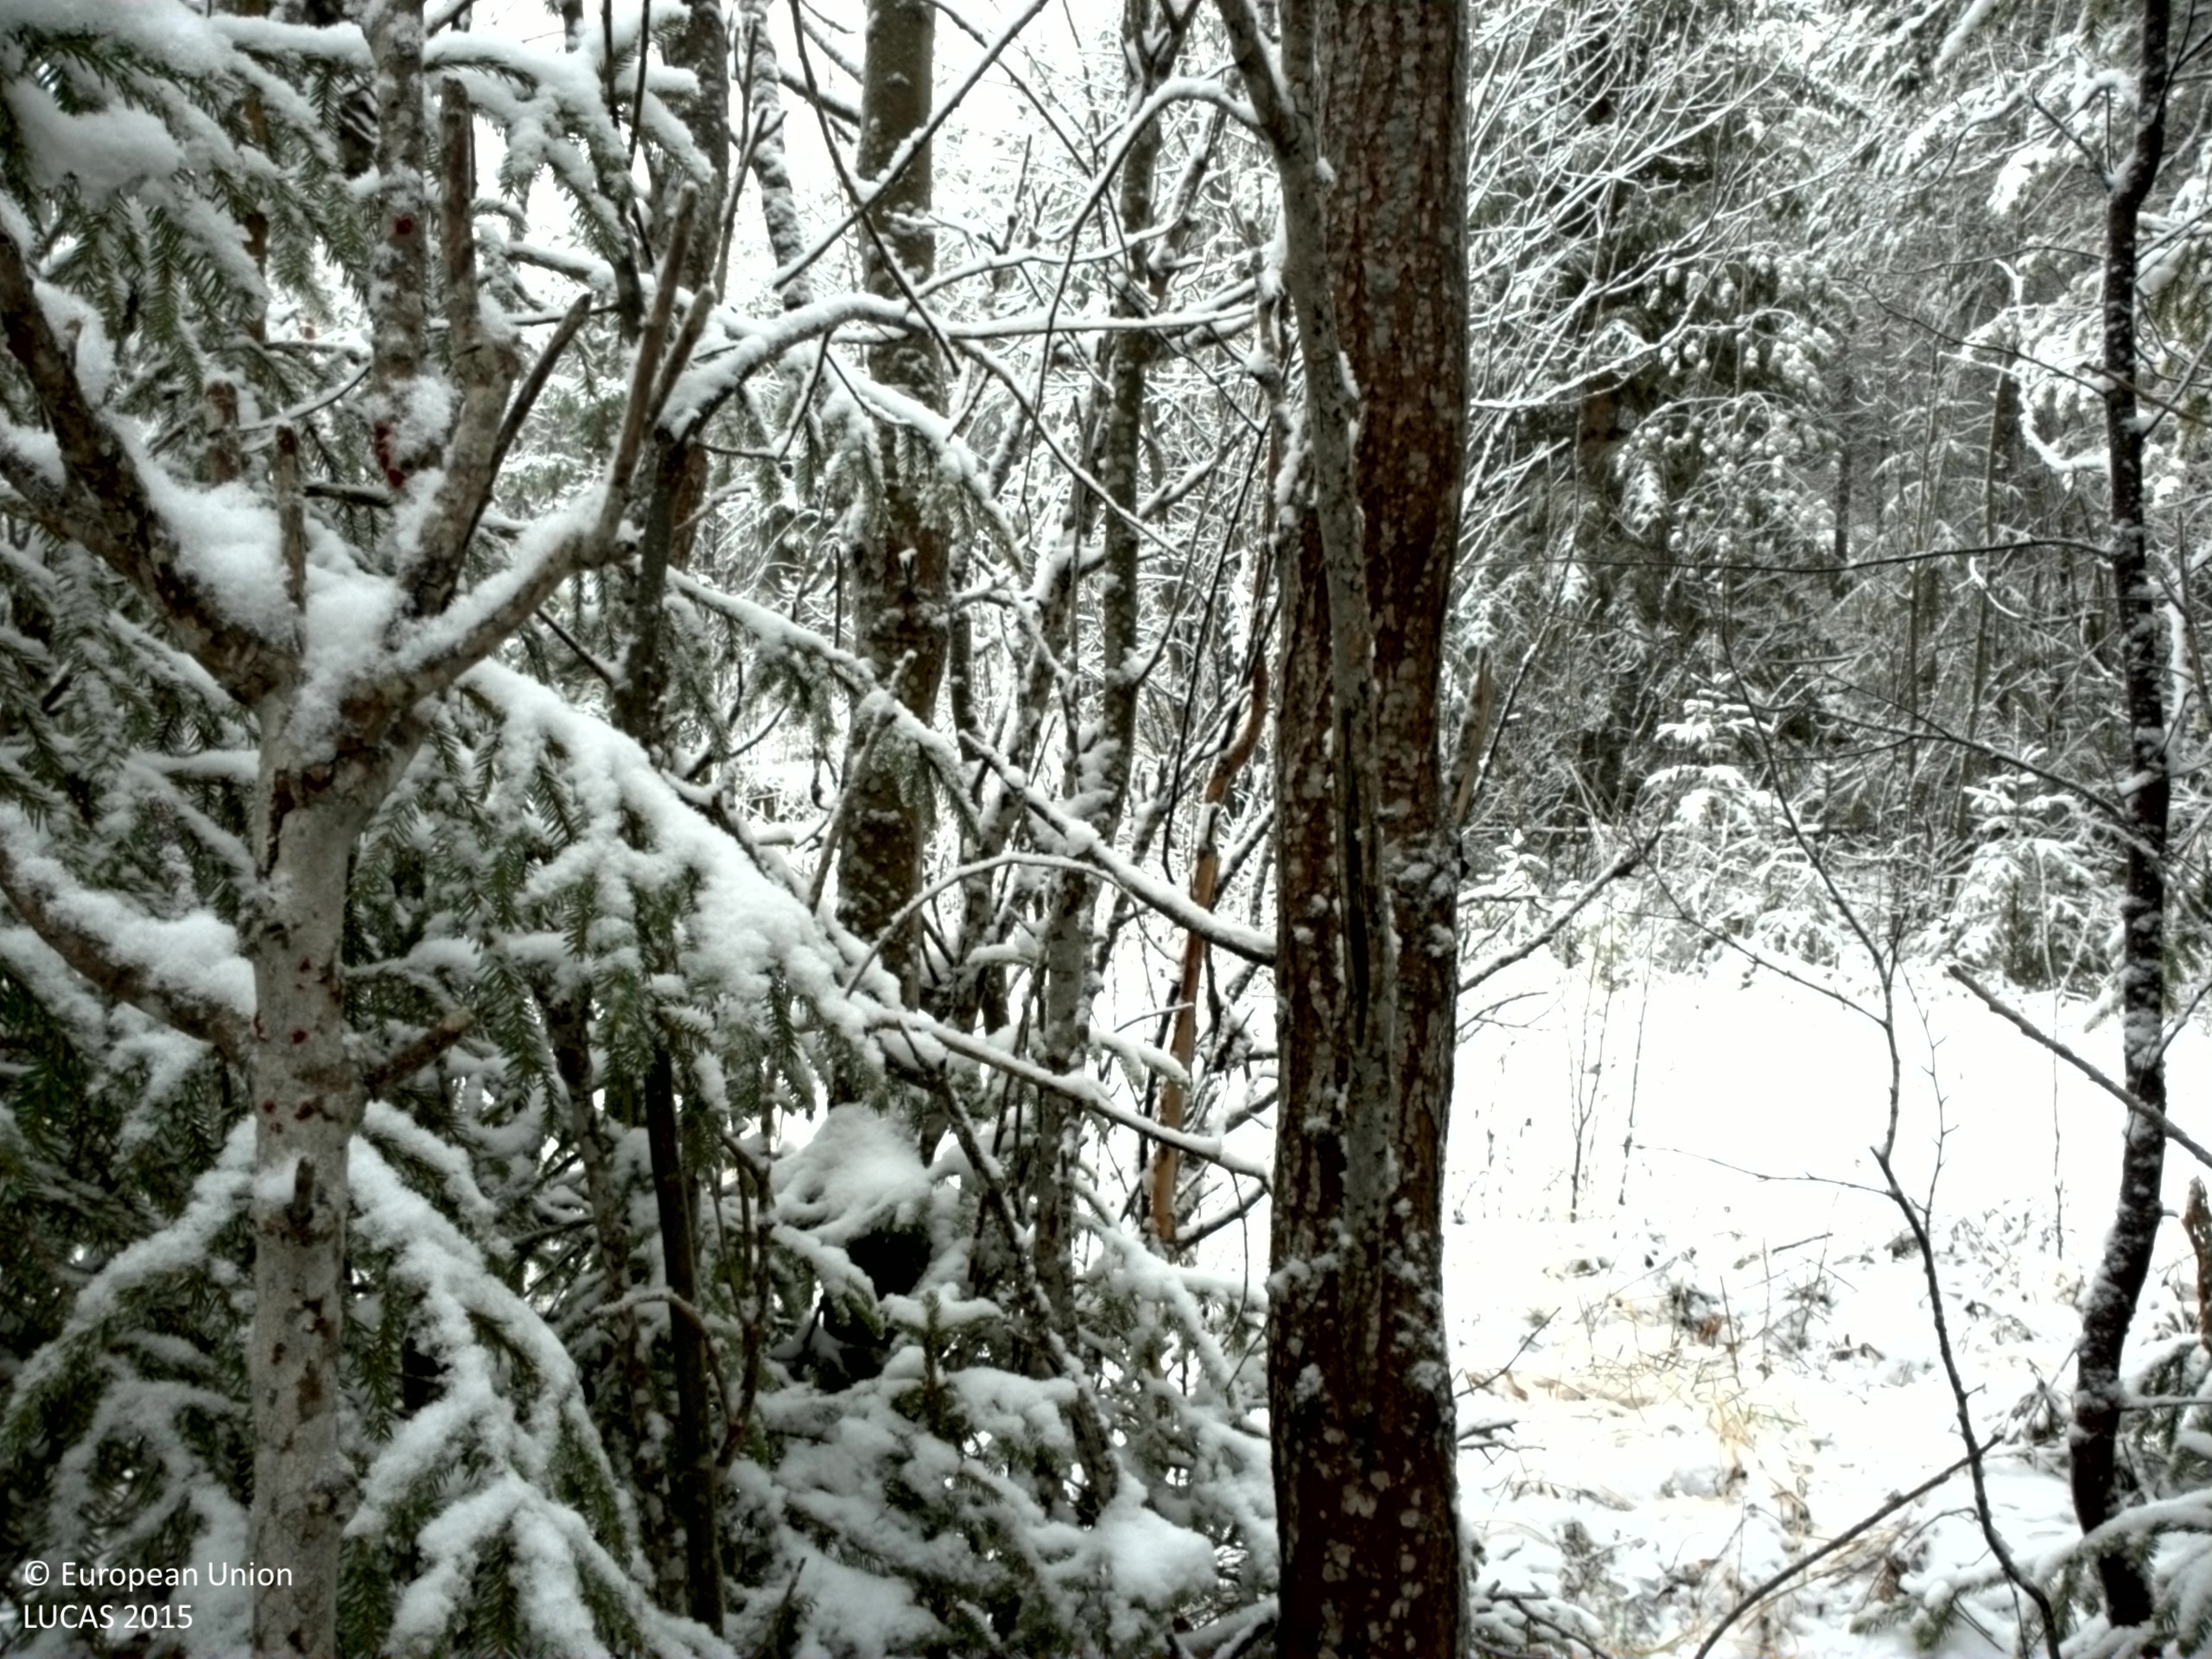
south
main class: Woodland
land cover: Other mixed woodland
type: boreal forest
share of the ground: 50 - 75 %
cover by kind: coniferous forest trees 35 %, broadleaved forest trees 25 %, shrubs 20 %, lichens and mosses 15 %, herbaceous plants 5 %
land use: Forestry
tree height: > 5 m
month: November
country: SE
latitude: 63.6739
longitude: 15.3709
